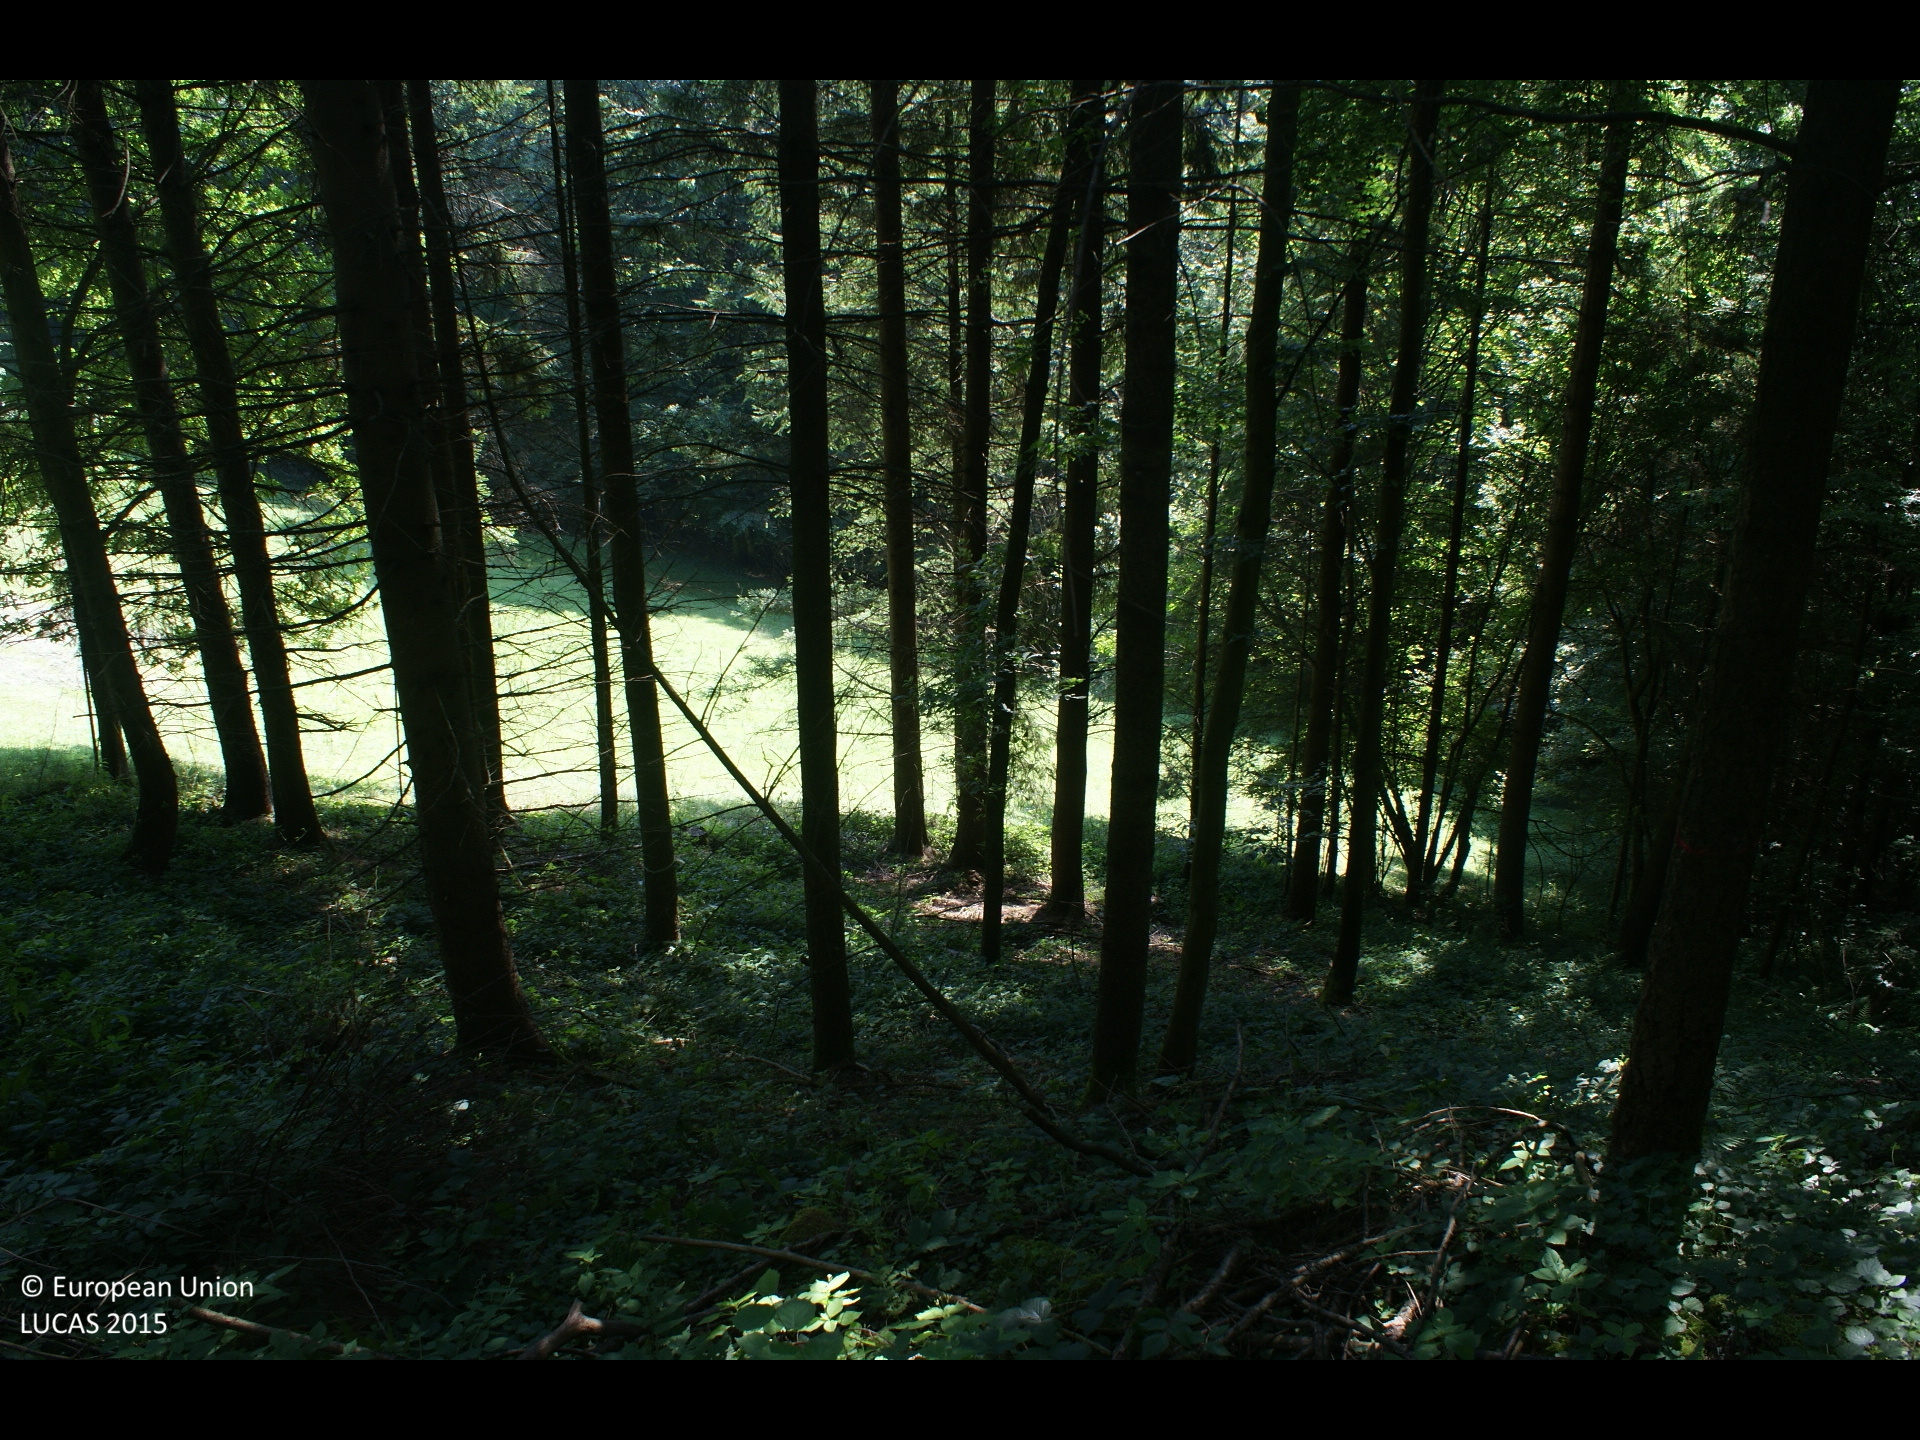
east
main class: Woodland
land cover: Spruce dominated mixed woodland
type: mesophytic deciduous forest
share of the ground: > 75 %
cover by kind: coniferous forest trees 50 %, broadleaved forest trees 40 %, herbaceous plants 10 %
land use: Forestry
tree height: > 5 m
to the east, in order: Spruce dominated mixed woodland; Fences; Grassland without tree/shrub cover; Broadleaved woodland; Fences; Broadleaved woodland; Rivers and streams; Broadleaved woodland; Rivers and streams; Broadleaved woodland; Tracks; Spruce dominated mixed woodland; Fences; Grassland without tree/shrub cover; Fences; Grass margins; Maize
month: July
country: AT
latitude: 48.0378
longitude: 15.0037
